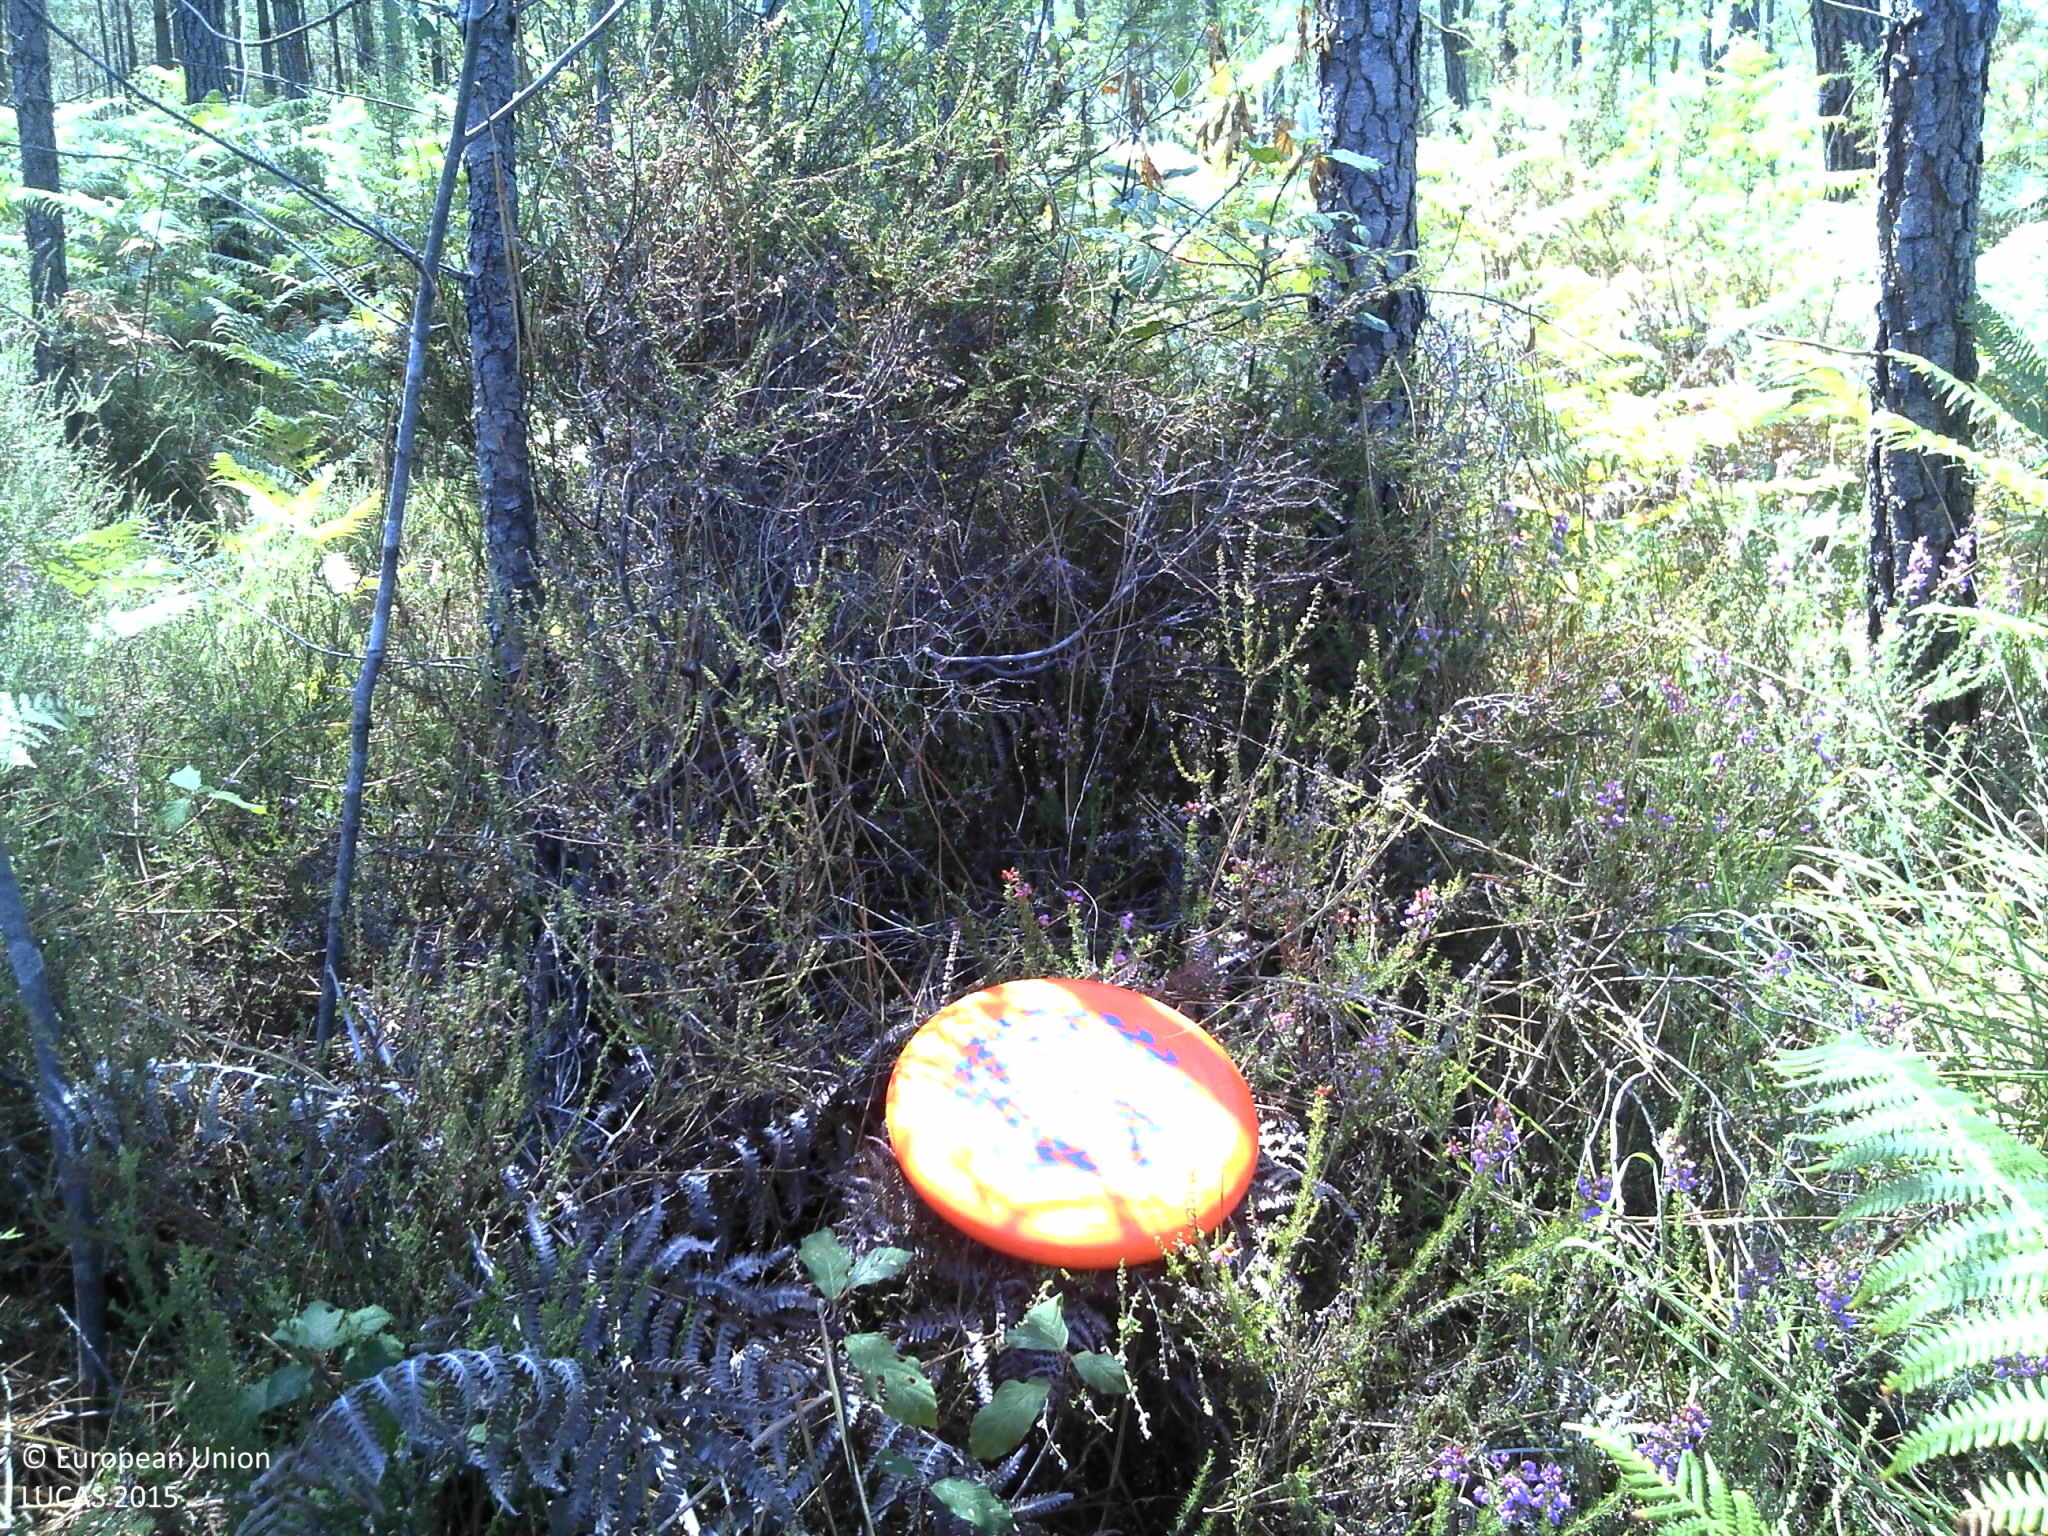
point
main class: Woodland
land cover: Pine dominated coniferous woodland
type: exotic forest
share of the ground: > 75 %
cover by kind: coniferous forest trees 60 %, shrubs 30 %, herbaceous plants 5 %, lichens and mosses 5 %
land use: Forestry
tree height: > 5 m
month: August
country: FR
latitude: 44.4822
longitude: -0.5651
